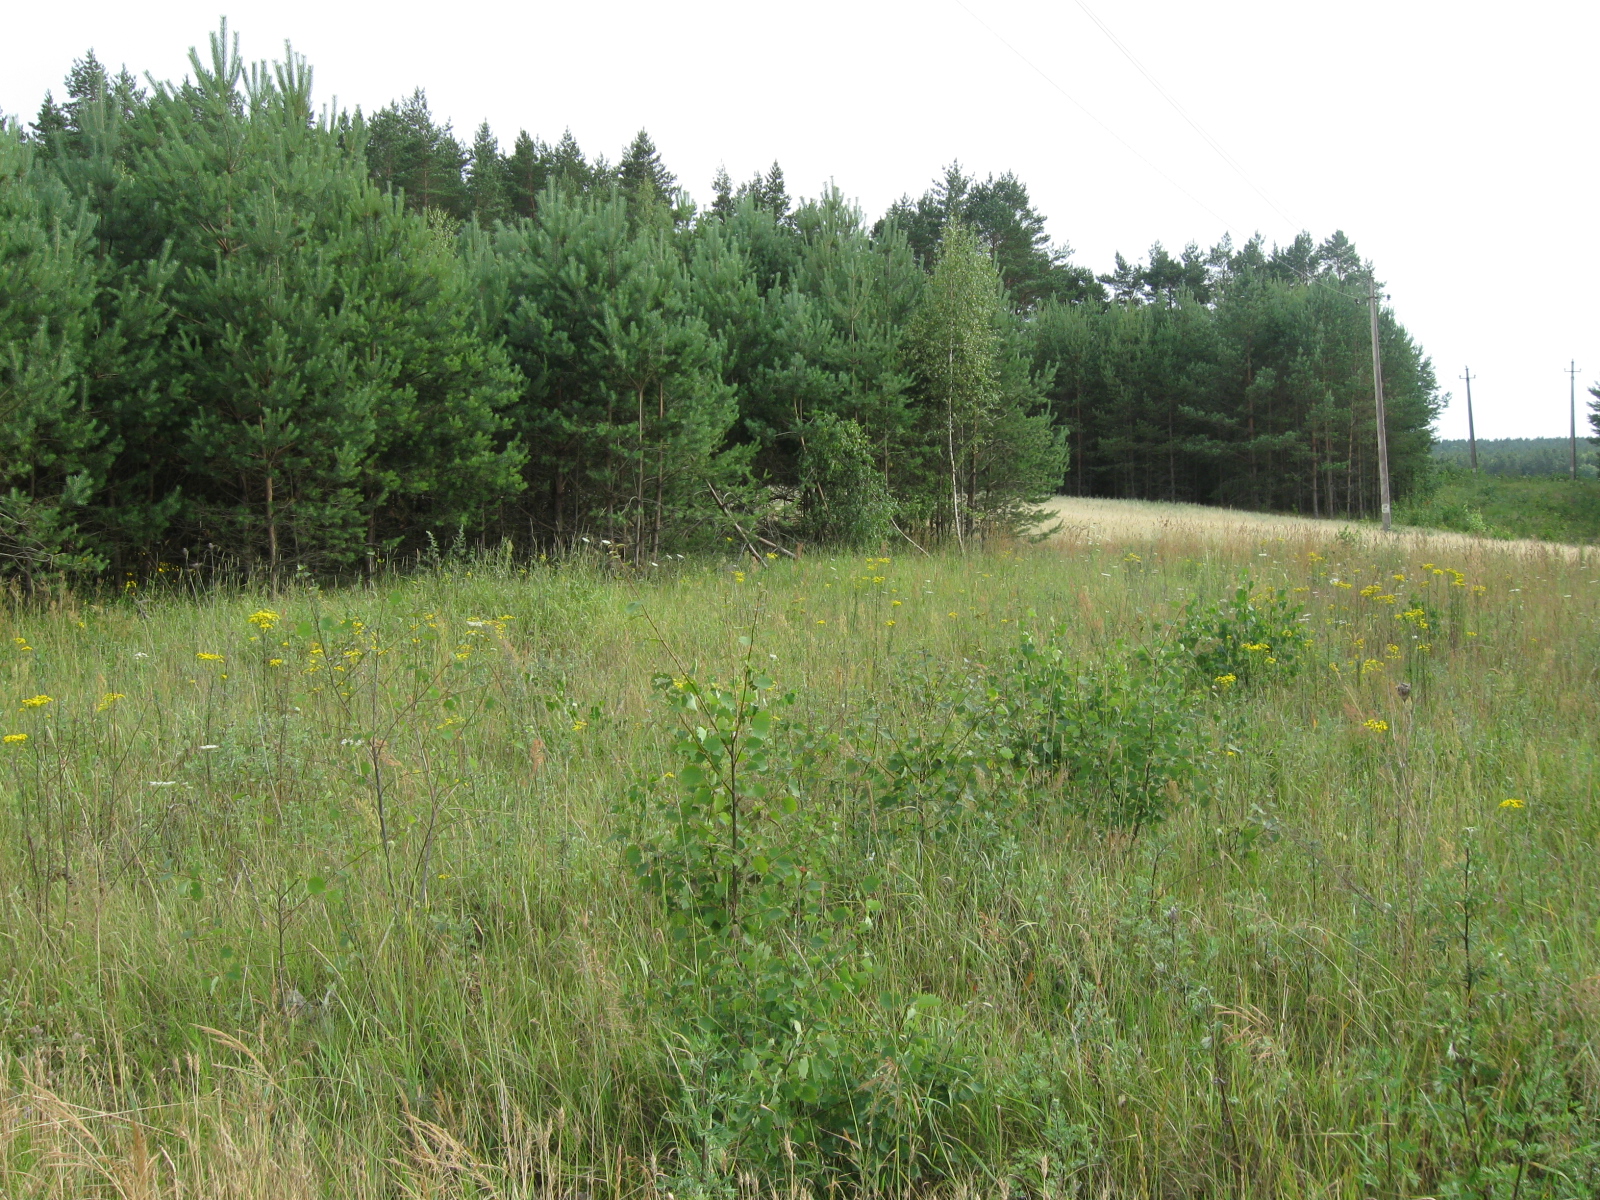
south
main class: Cropland
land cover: Durum wheat
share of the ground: > 75 %
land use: Agriculture (excluding fallow land and kitchen gardens)
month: July
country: LT
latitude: 54.6130
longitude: 23.9807
